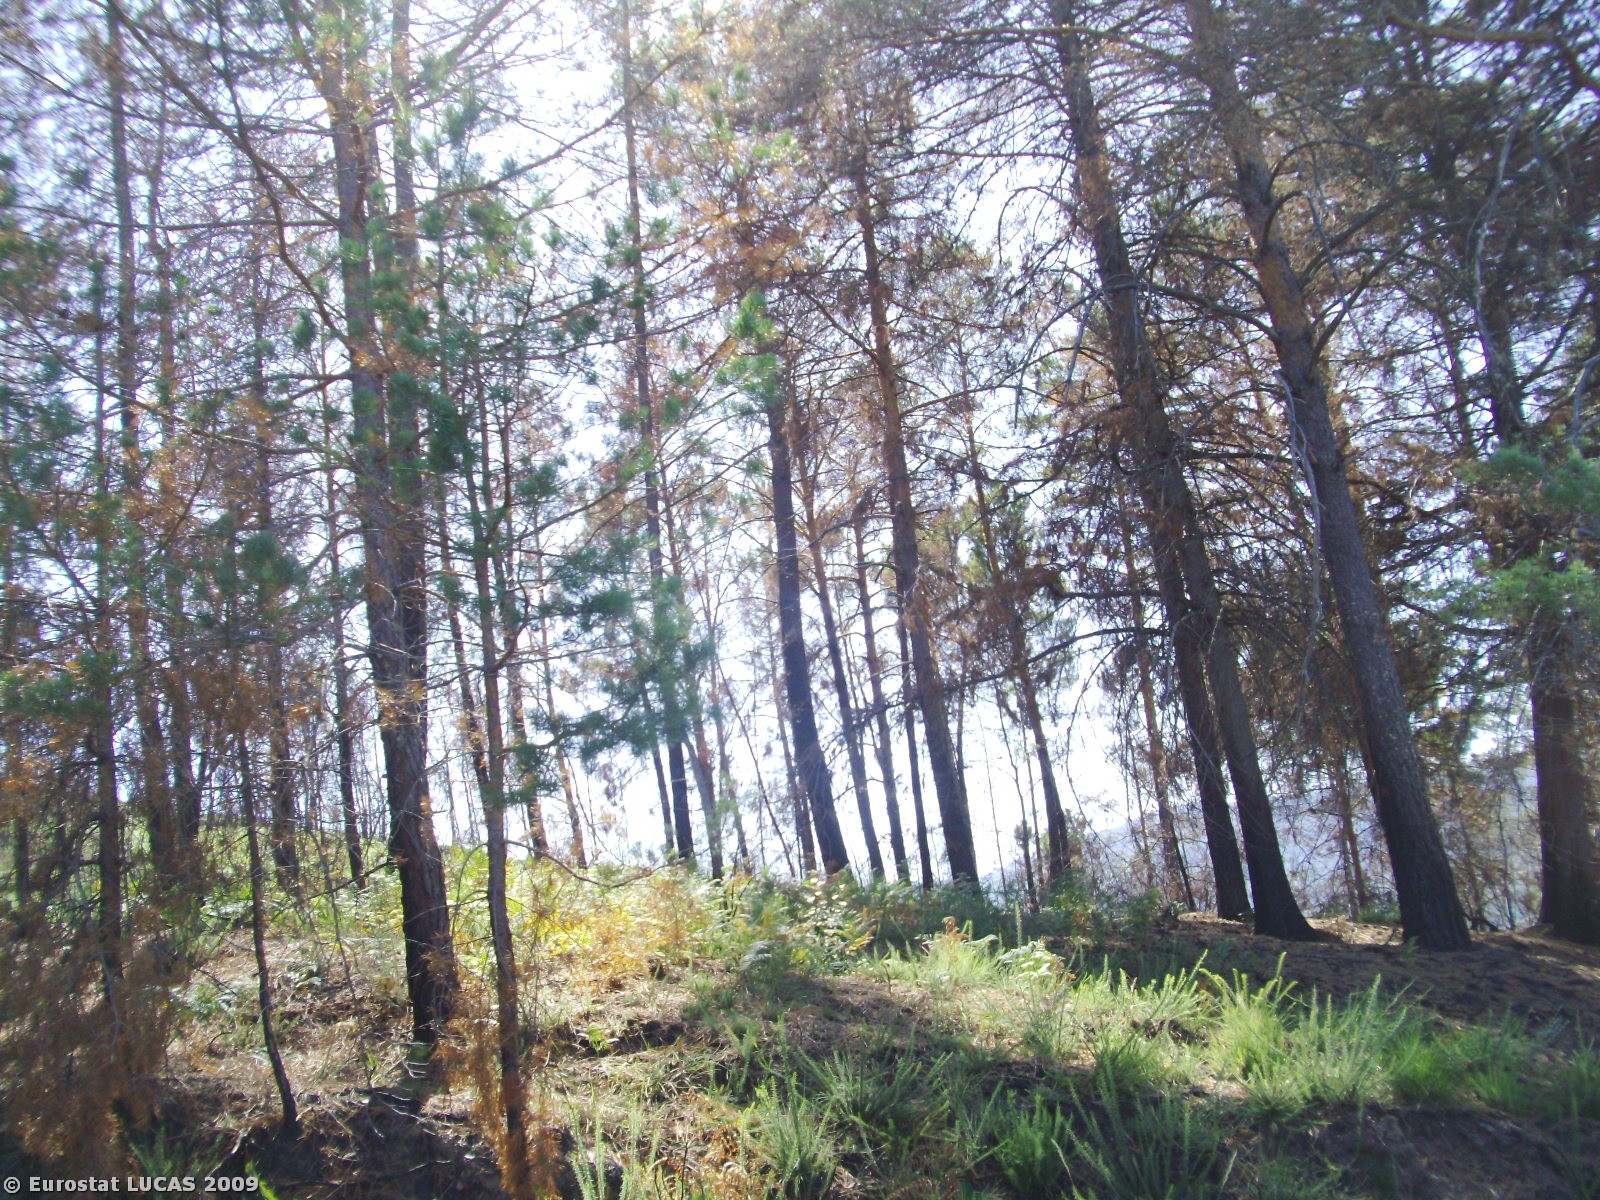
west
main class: Woodland
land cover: Coniferous woodland
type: coniferous forest of the mediterranean region
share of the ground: > 75 %
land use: Forestry
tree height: > 5 m
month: August
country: PT
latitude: 41.6820
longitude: -7.6369
